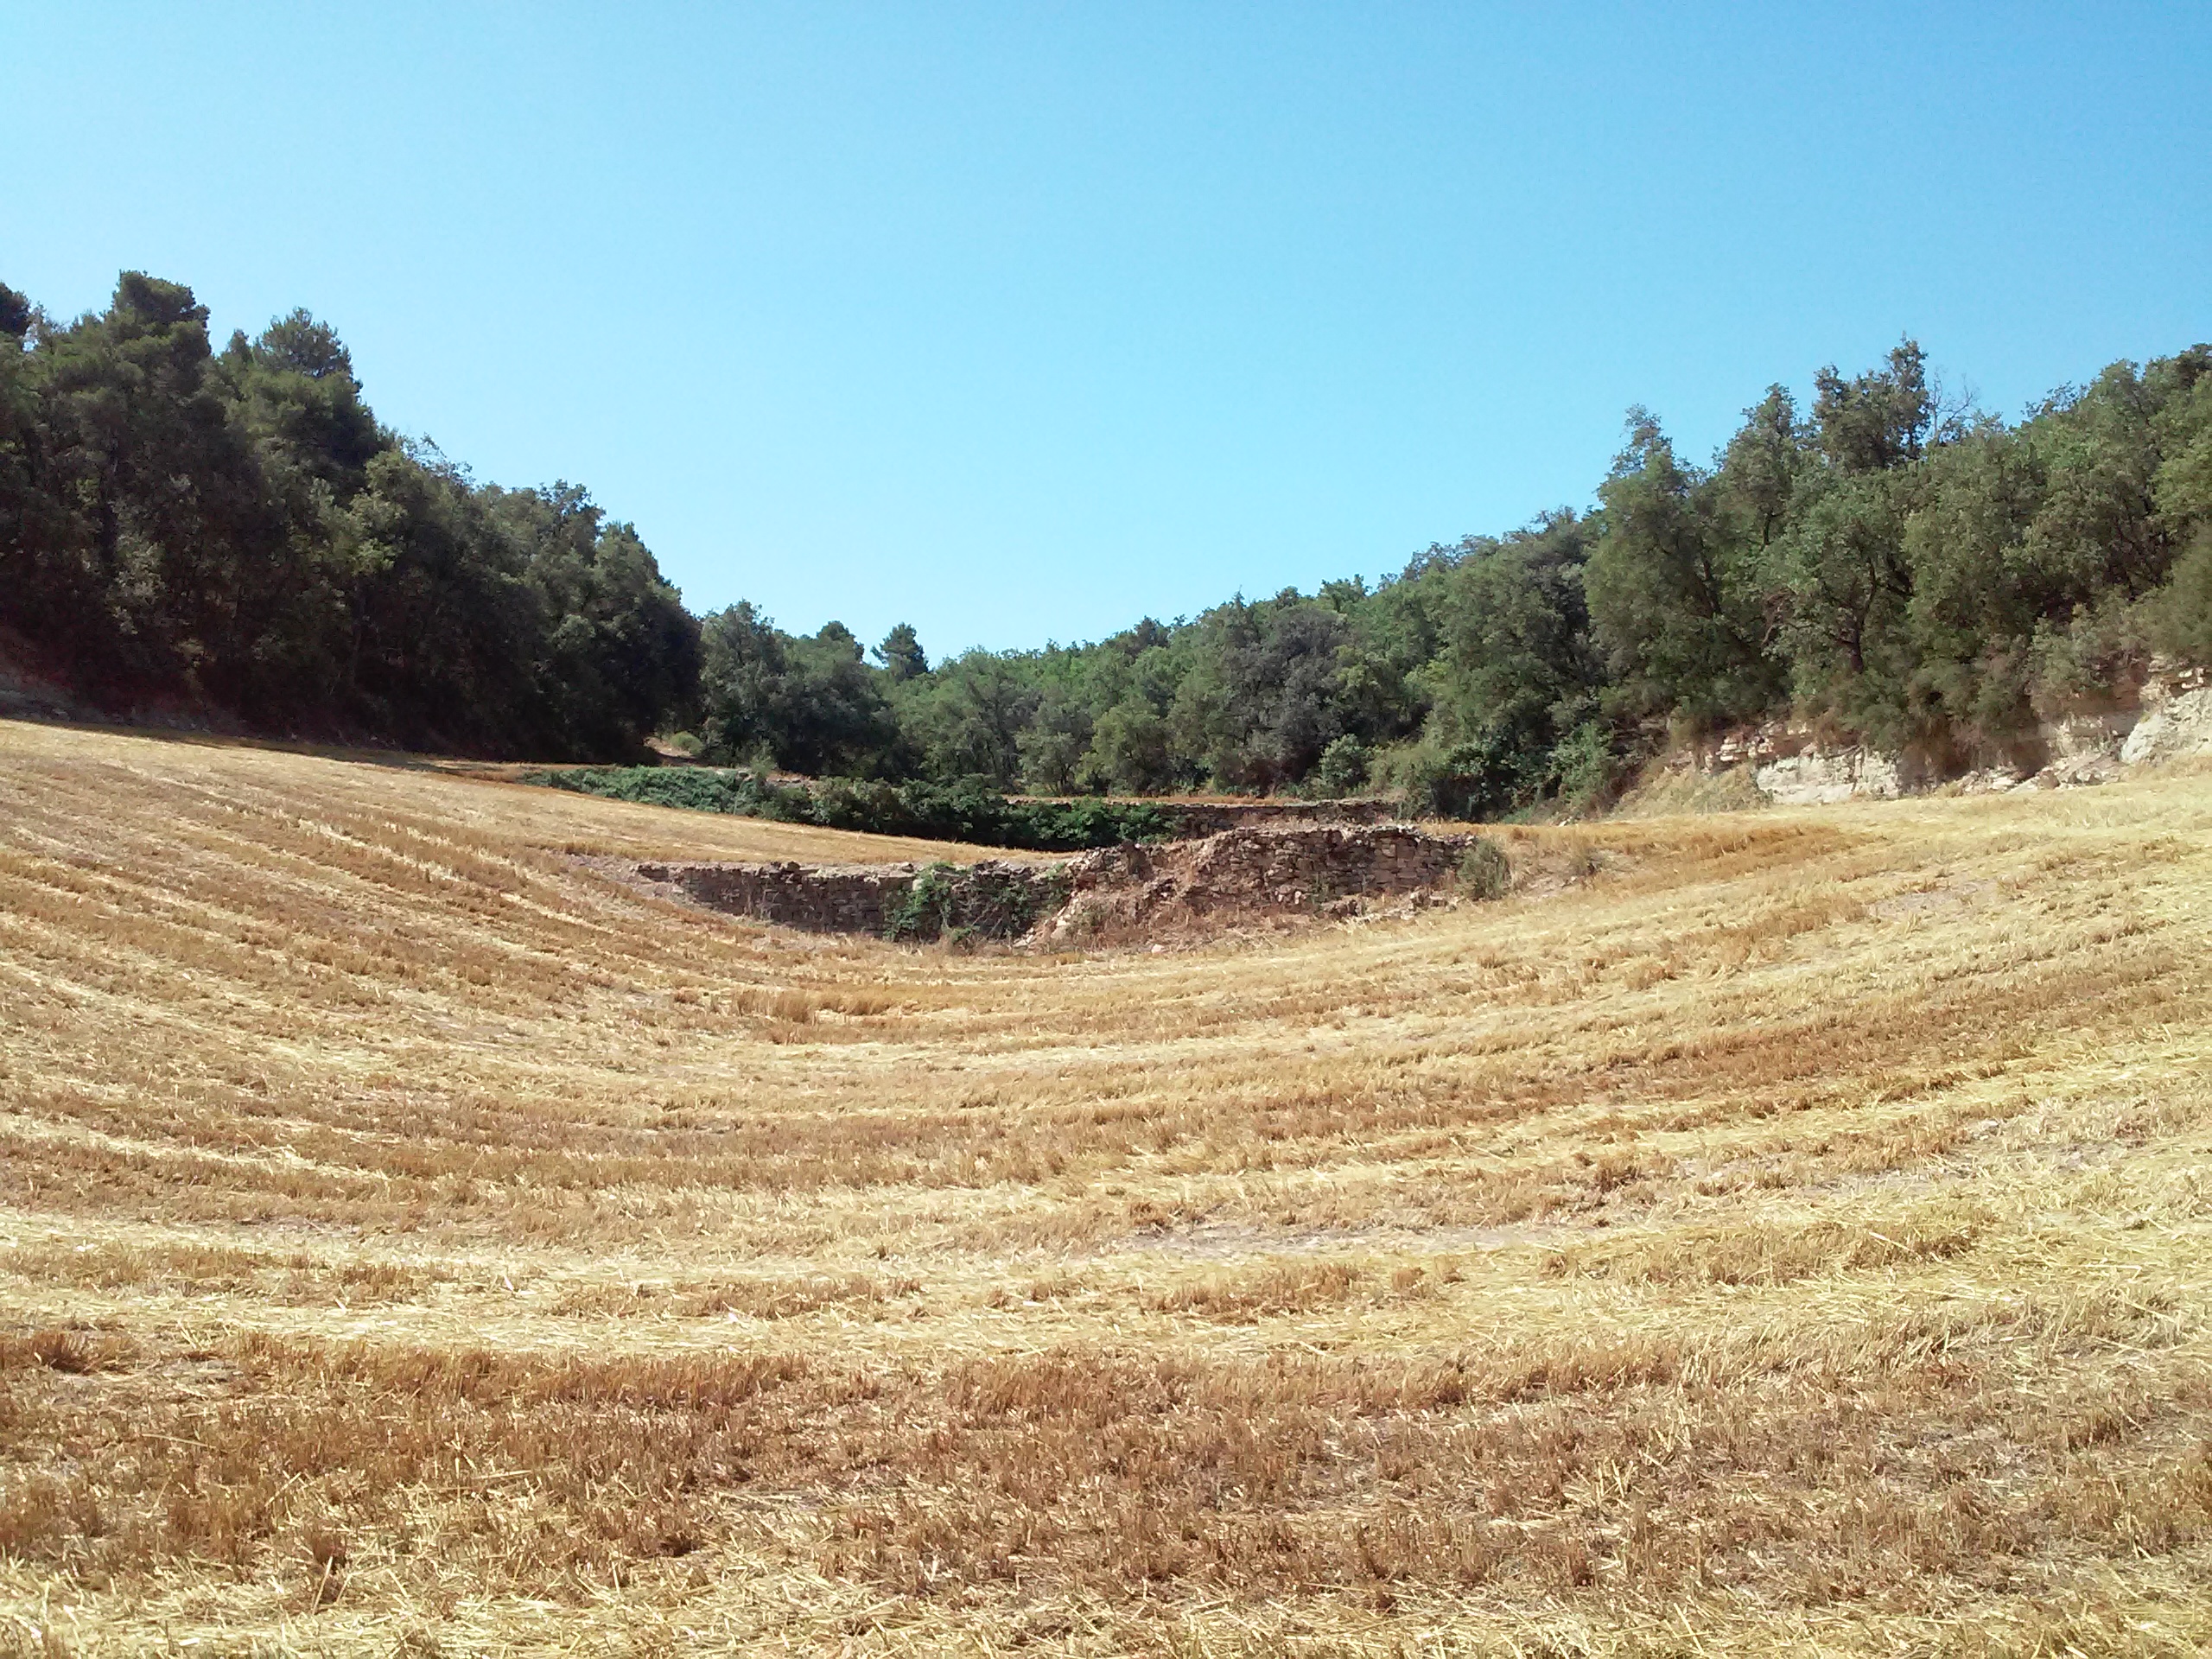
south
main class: Cropland
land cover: Barley
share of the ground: < 10 %
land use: Agriculture (excluding fallow land and kitchen gardens)
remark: Harvested field
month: July
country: ES
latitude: 41.5822
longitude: 1.2223
